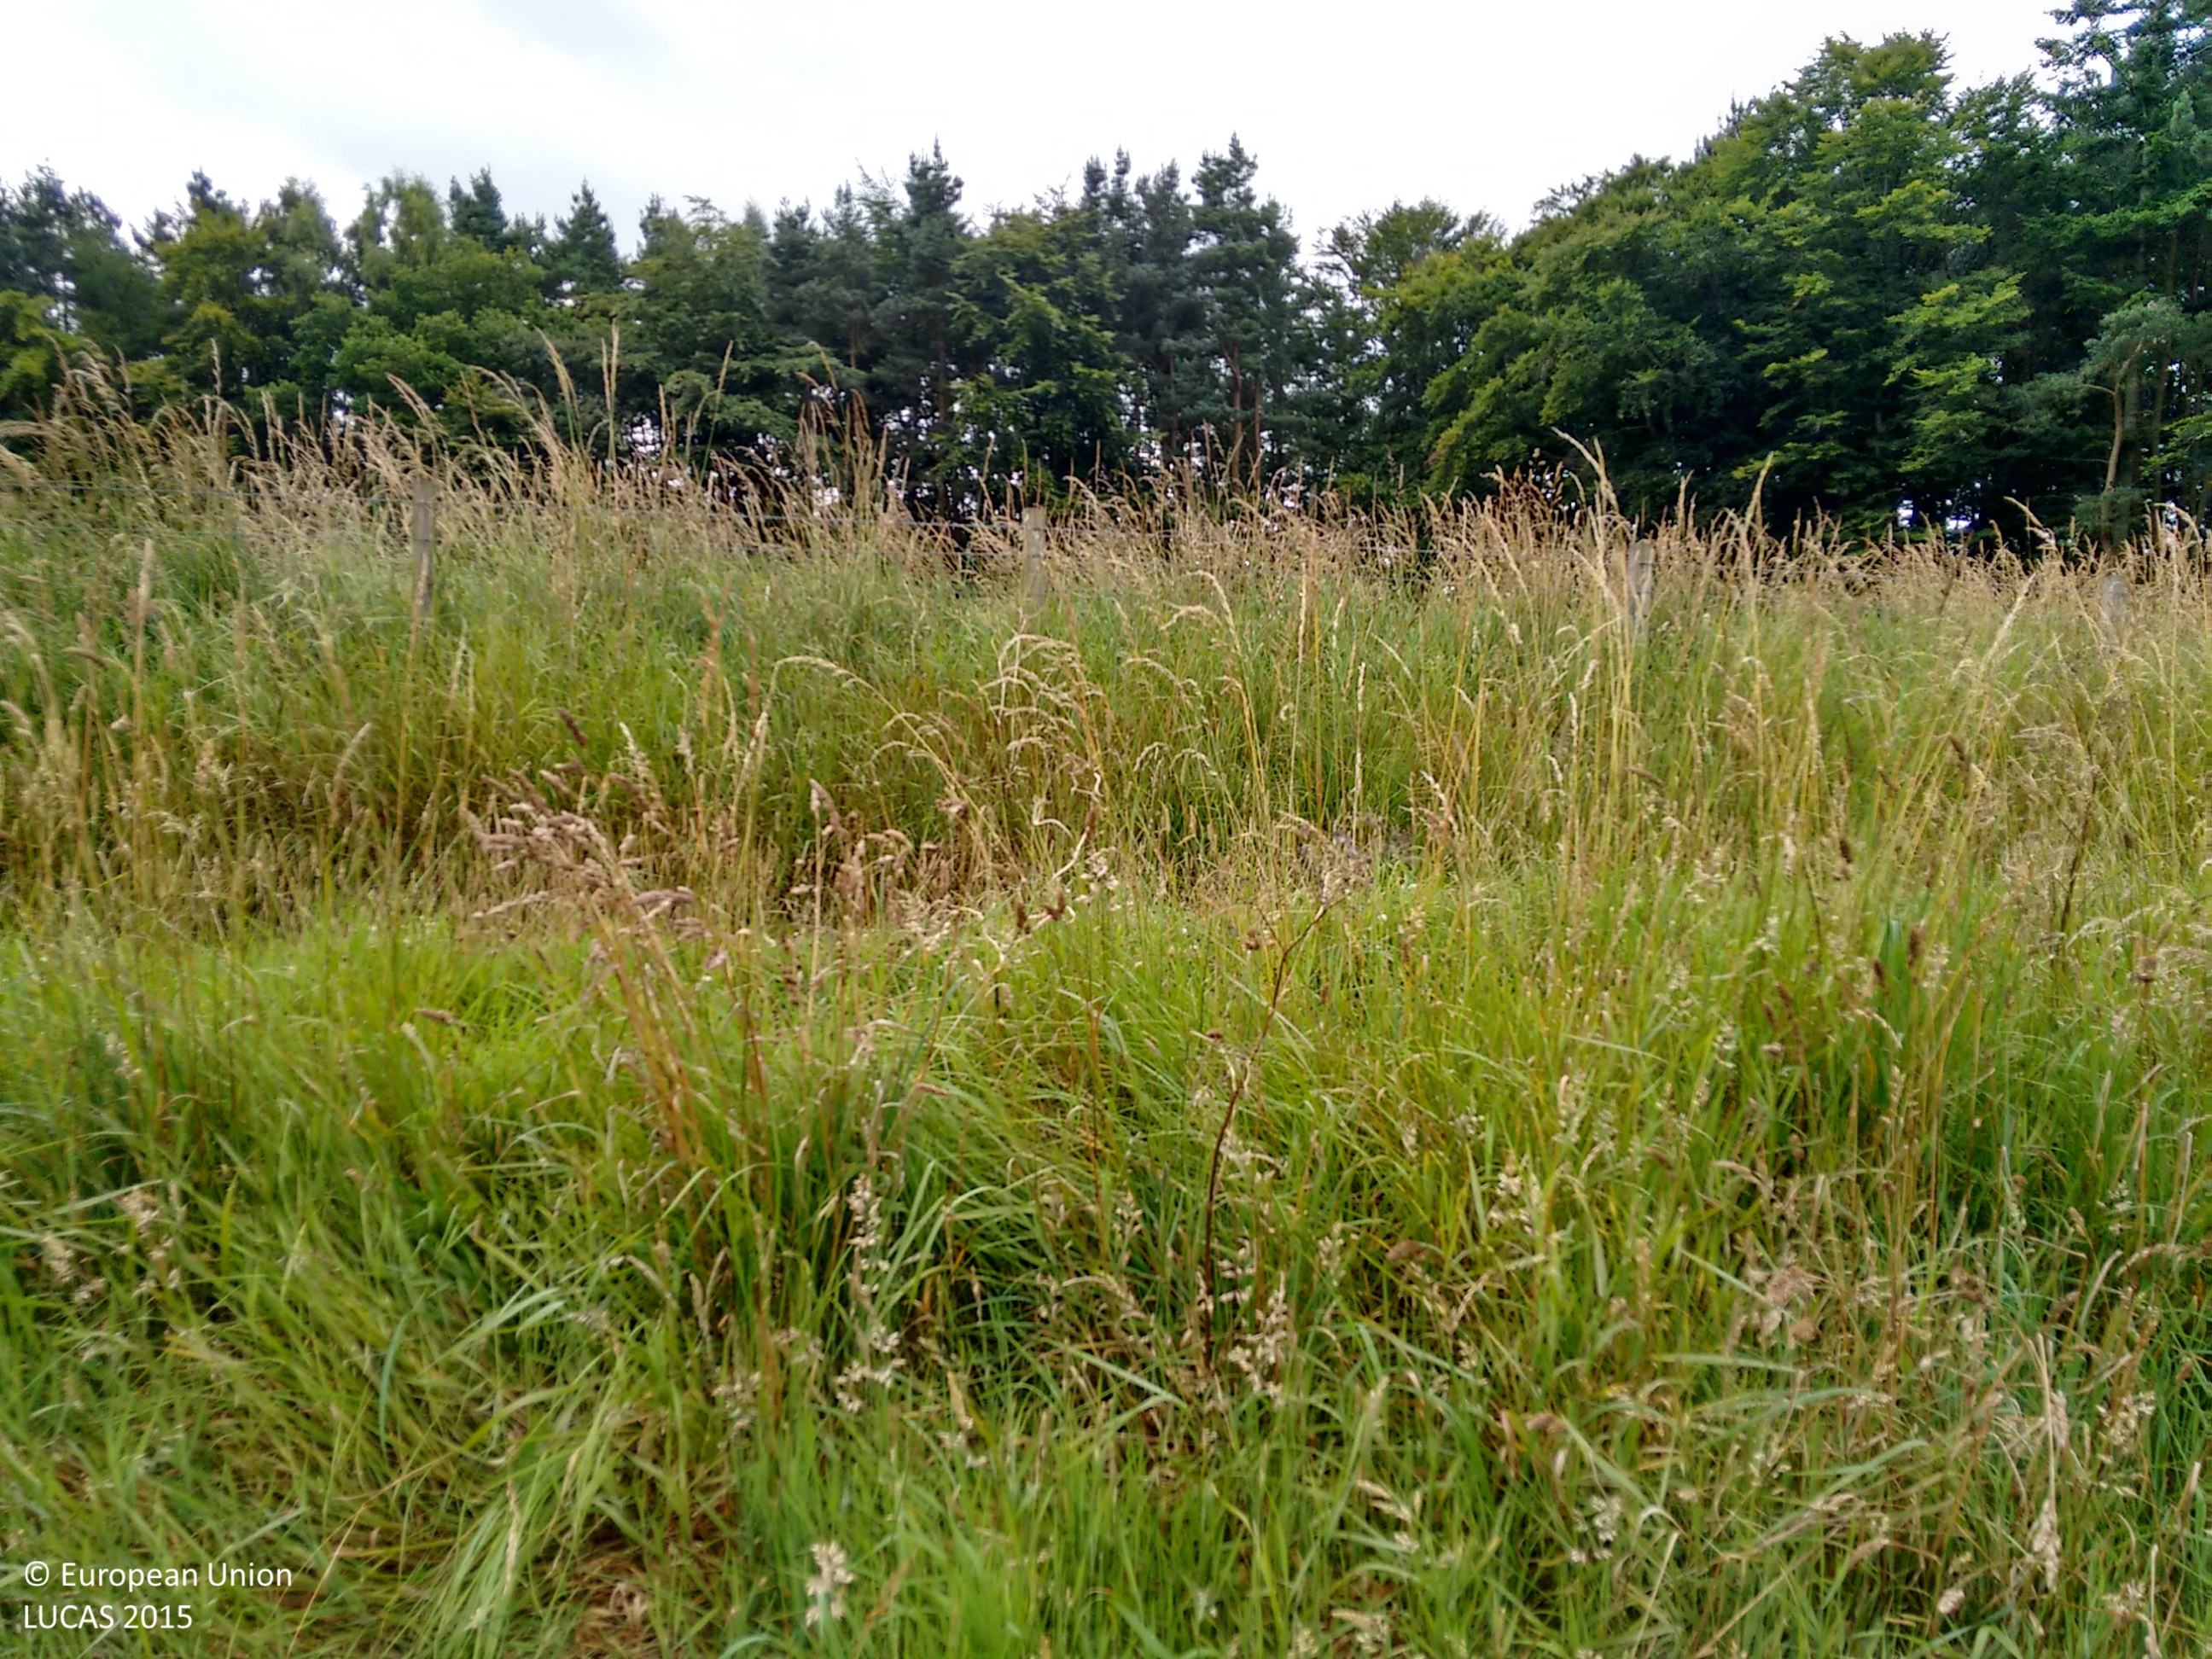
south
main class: Cropland
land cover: Dry pulses
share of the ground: > 75 %
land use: Agriculture (excluding fallow land and kitchen gardens)
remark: Tilled/Sowed
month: August
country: GB
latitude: 55.5940
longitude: -2.2920
